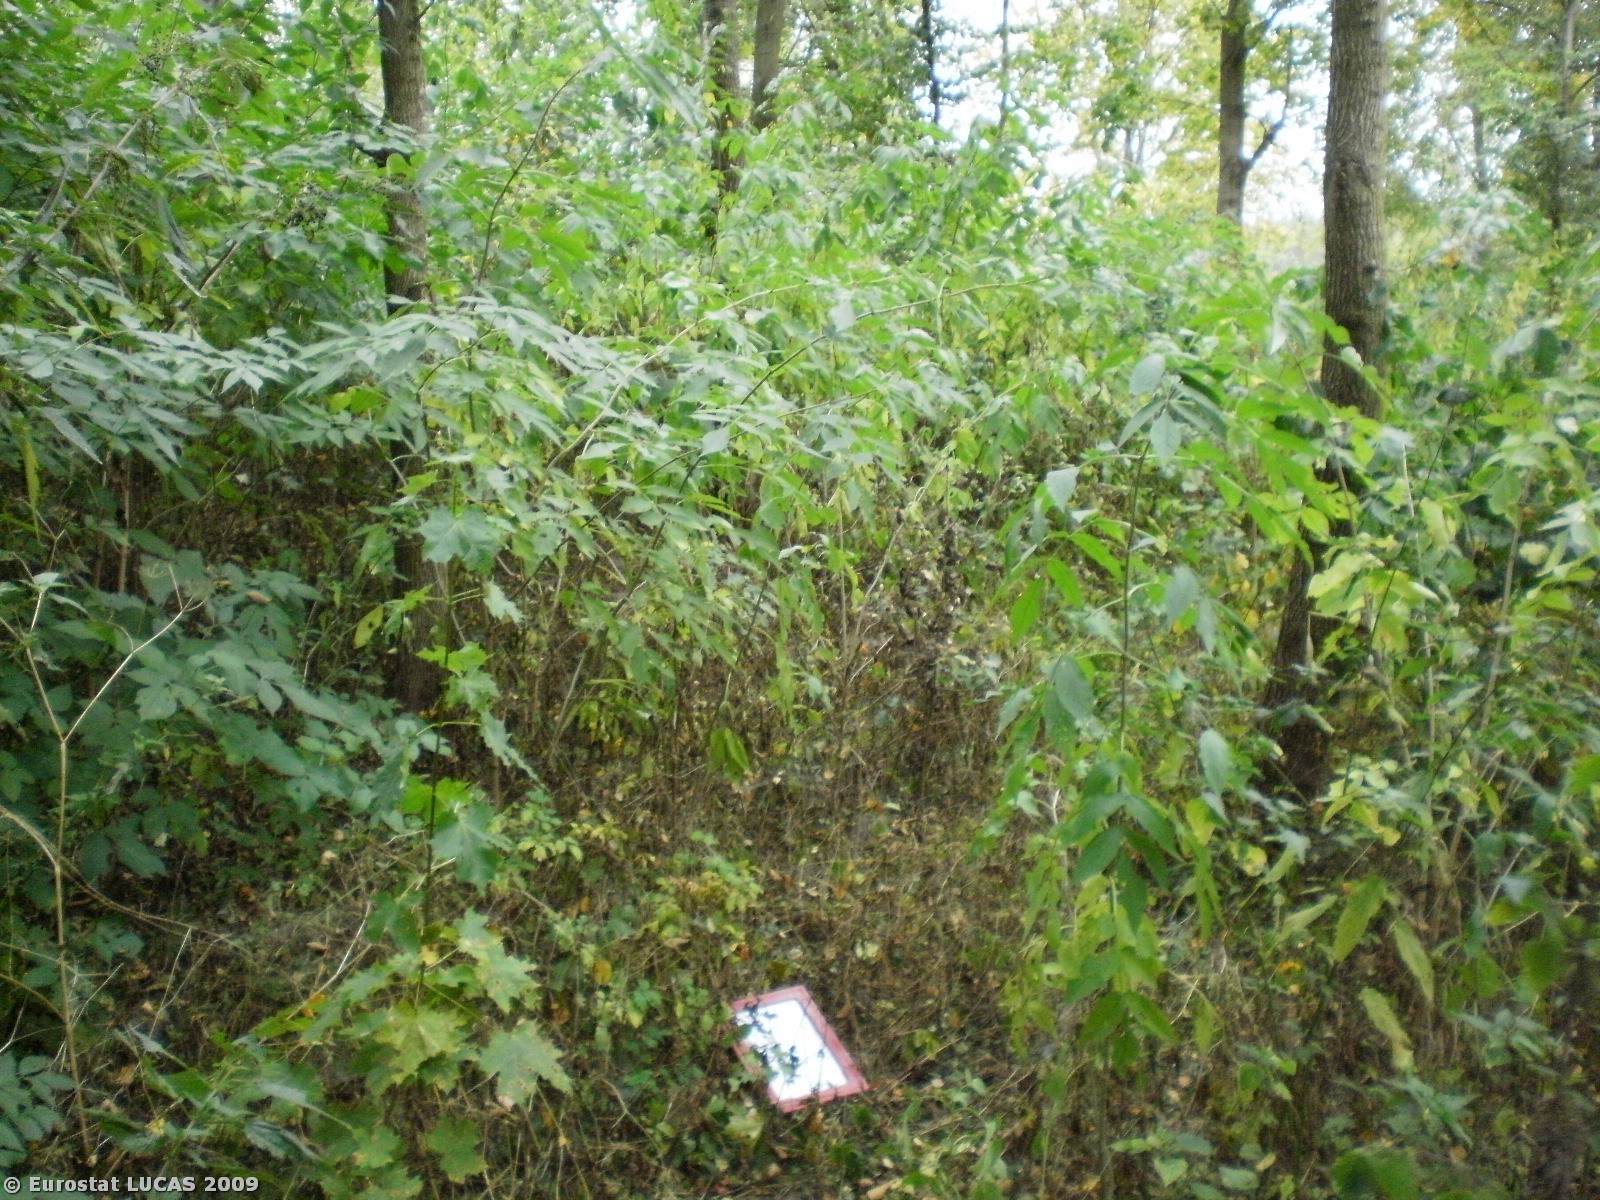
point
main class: Woodland
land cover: Broadleaved woodland
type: mesophytic deciduous forest
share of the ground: > 75 %
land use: Forestry
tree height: > 5 m
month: August
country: PL
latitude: 53.5339
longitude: 21.9609
